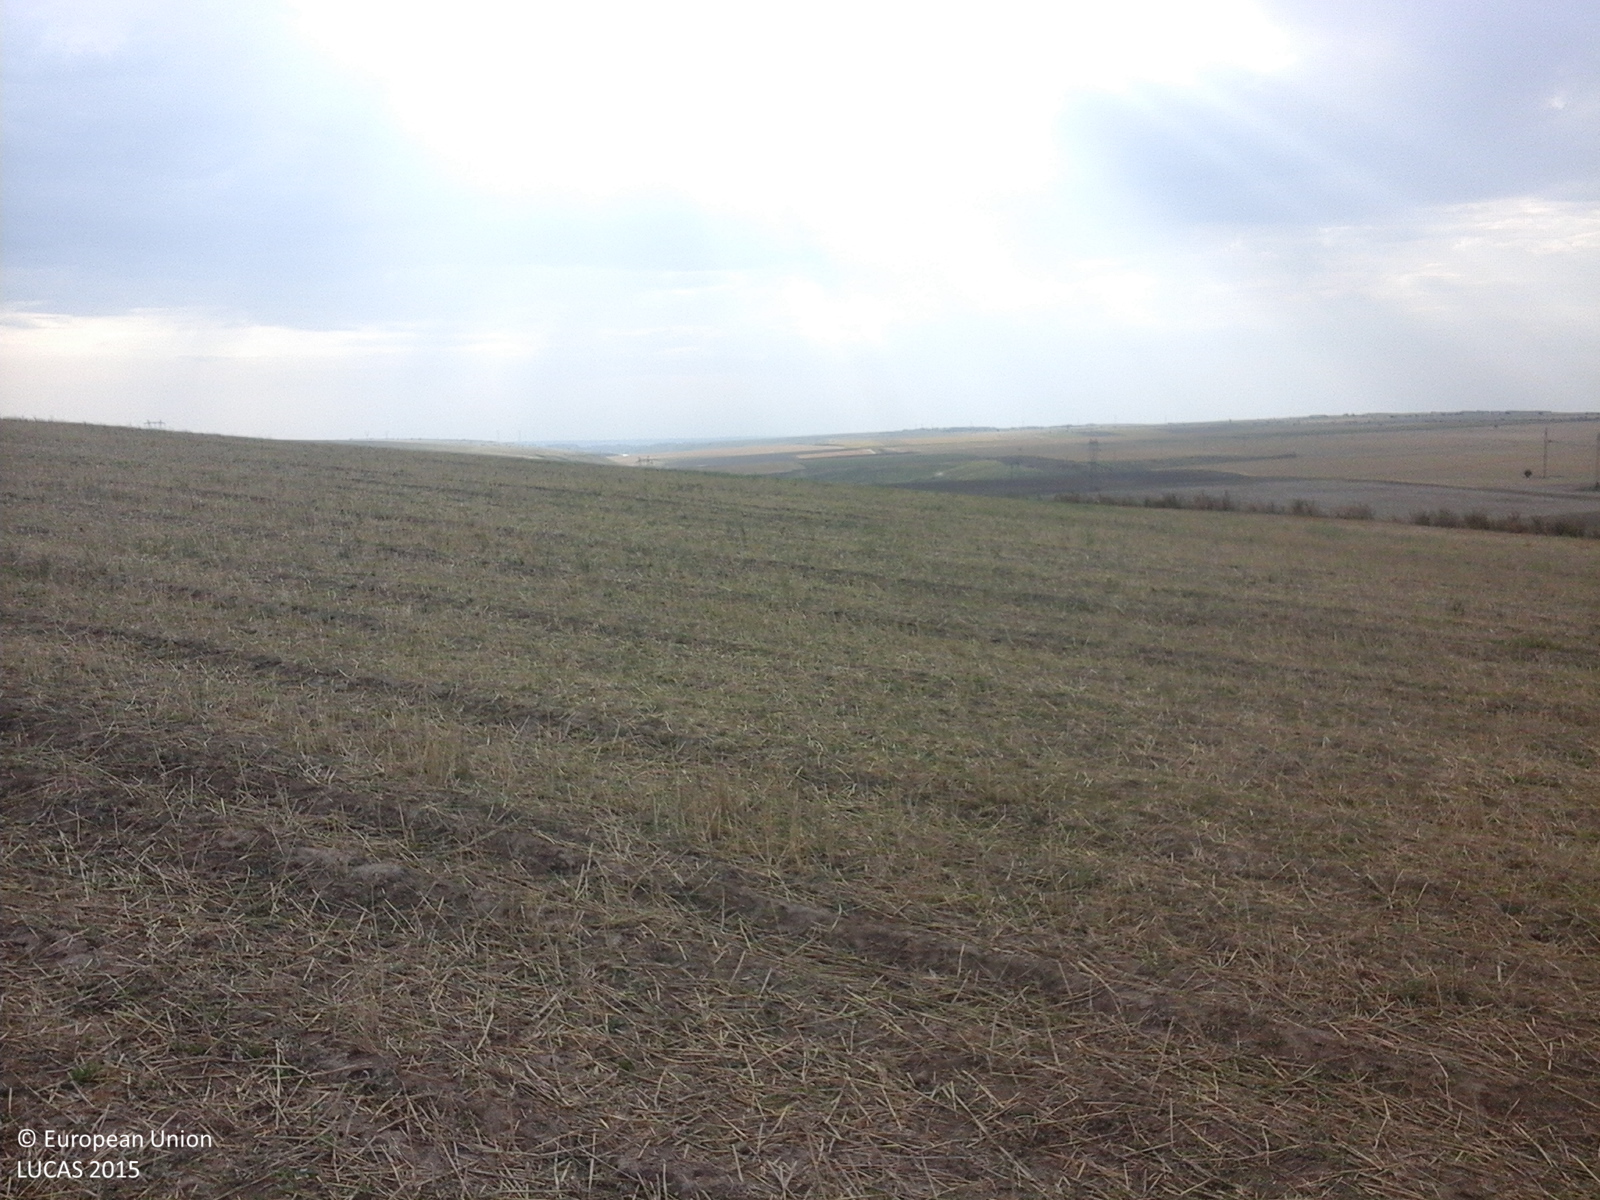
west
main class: Cropland
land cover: Common wheat
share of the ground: 25 - 50 %
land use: Agriculture (excluding fallow land and kitchen gardens)
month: August
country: RO
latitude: 44.3763
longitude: 28.1458
